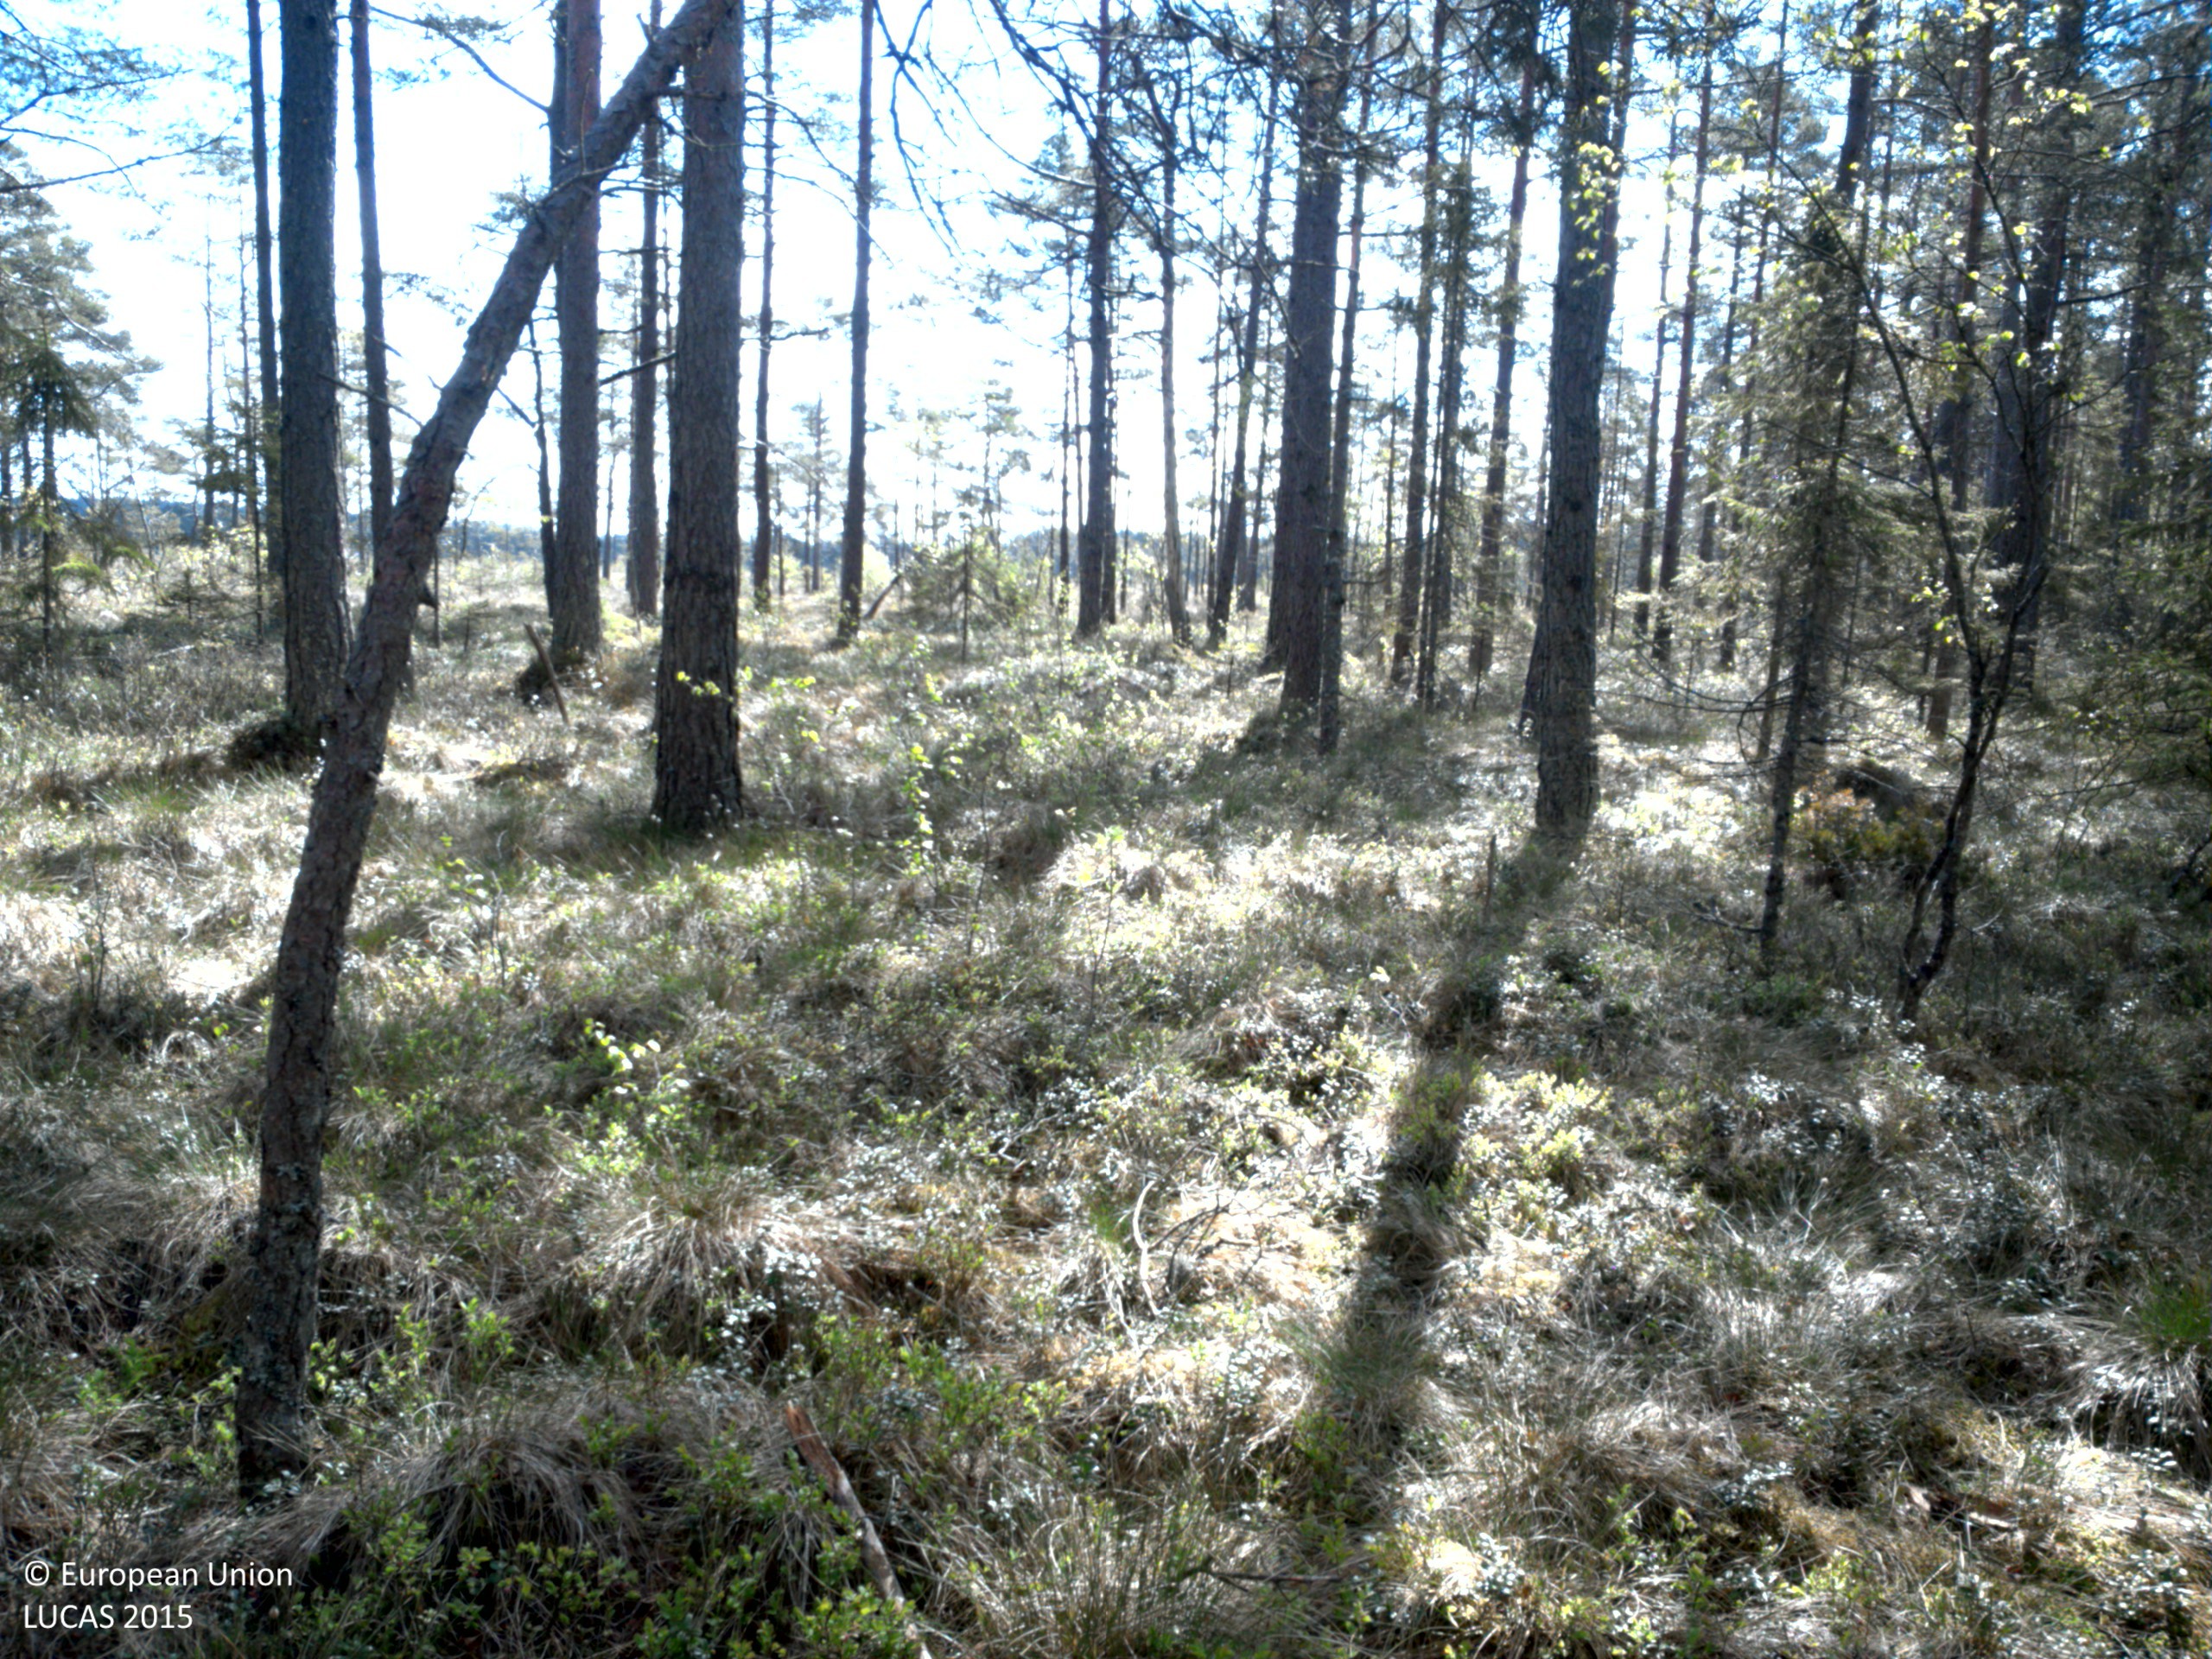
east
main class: Woodland
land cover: Pine dominated mixed woodland
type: boreal forest
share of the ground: > 75 %
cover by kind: coniferous forest trees 60 %, broadleaved forest trees 20 %, herbaceous plants 20 %
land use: Forestry
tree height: > 5 m
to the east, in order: Pine dominated mixed woodland; Pine dominated coniferous woodland; Peatbogs
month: May
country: SE
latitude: 57.8603
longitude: 13.0795
